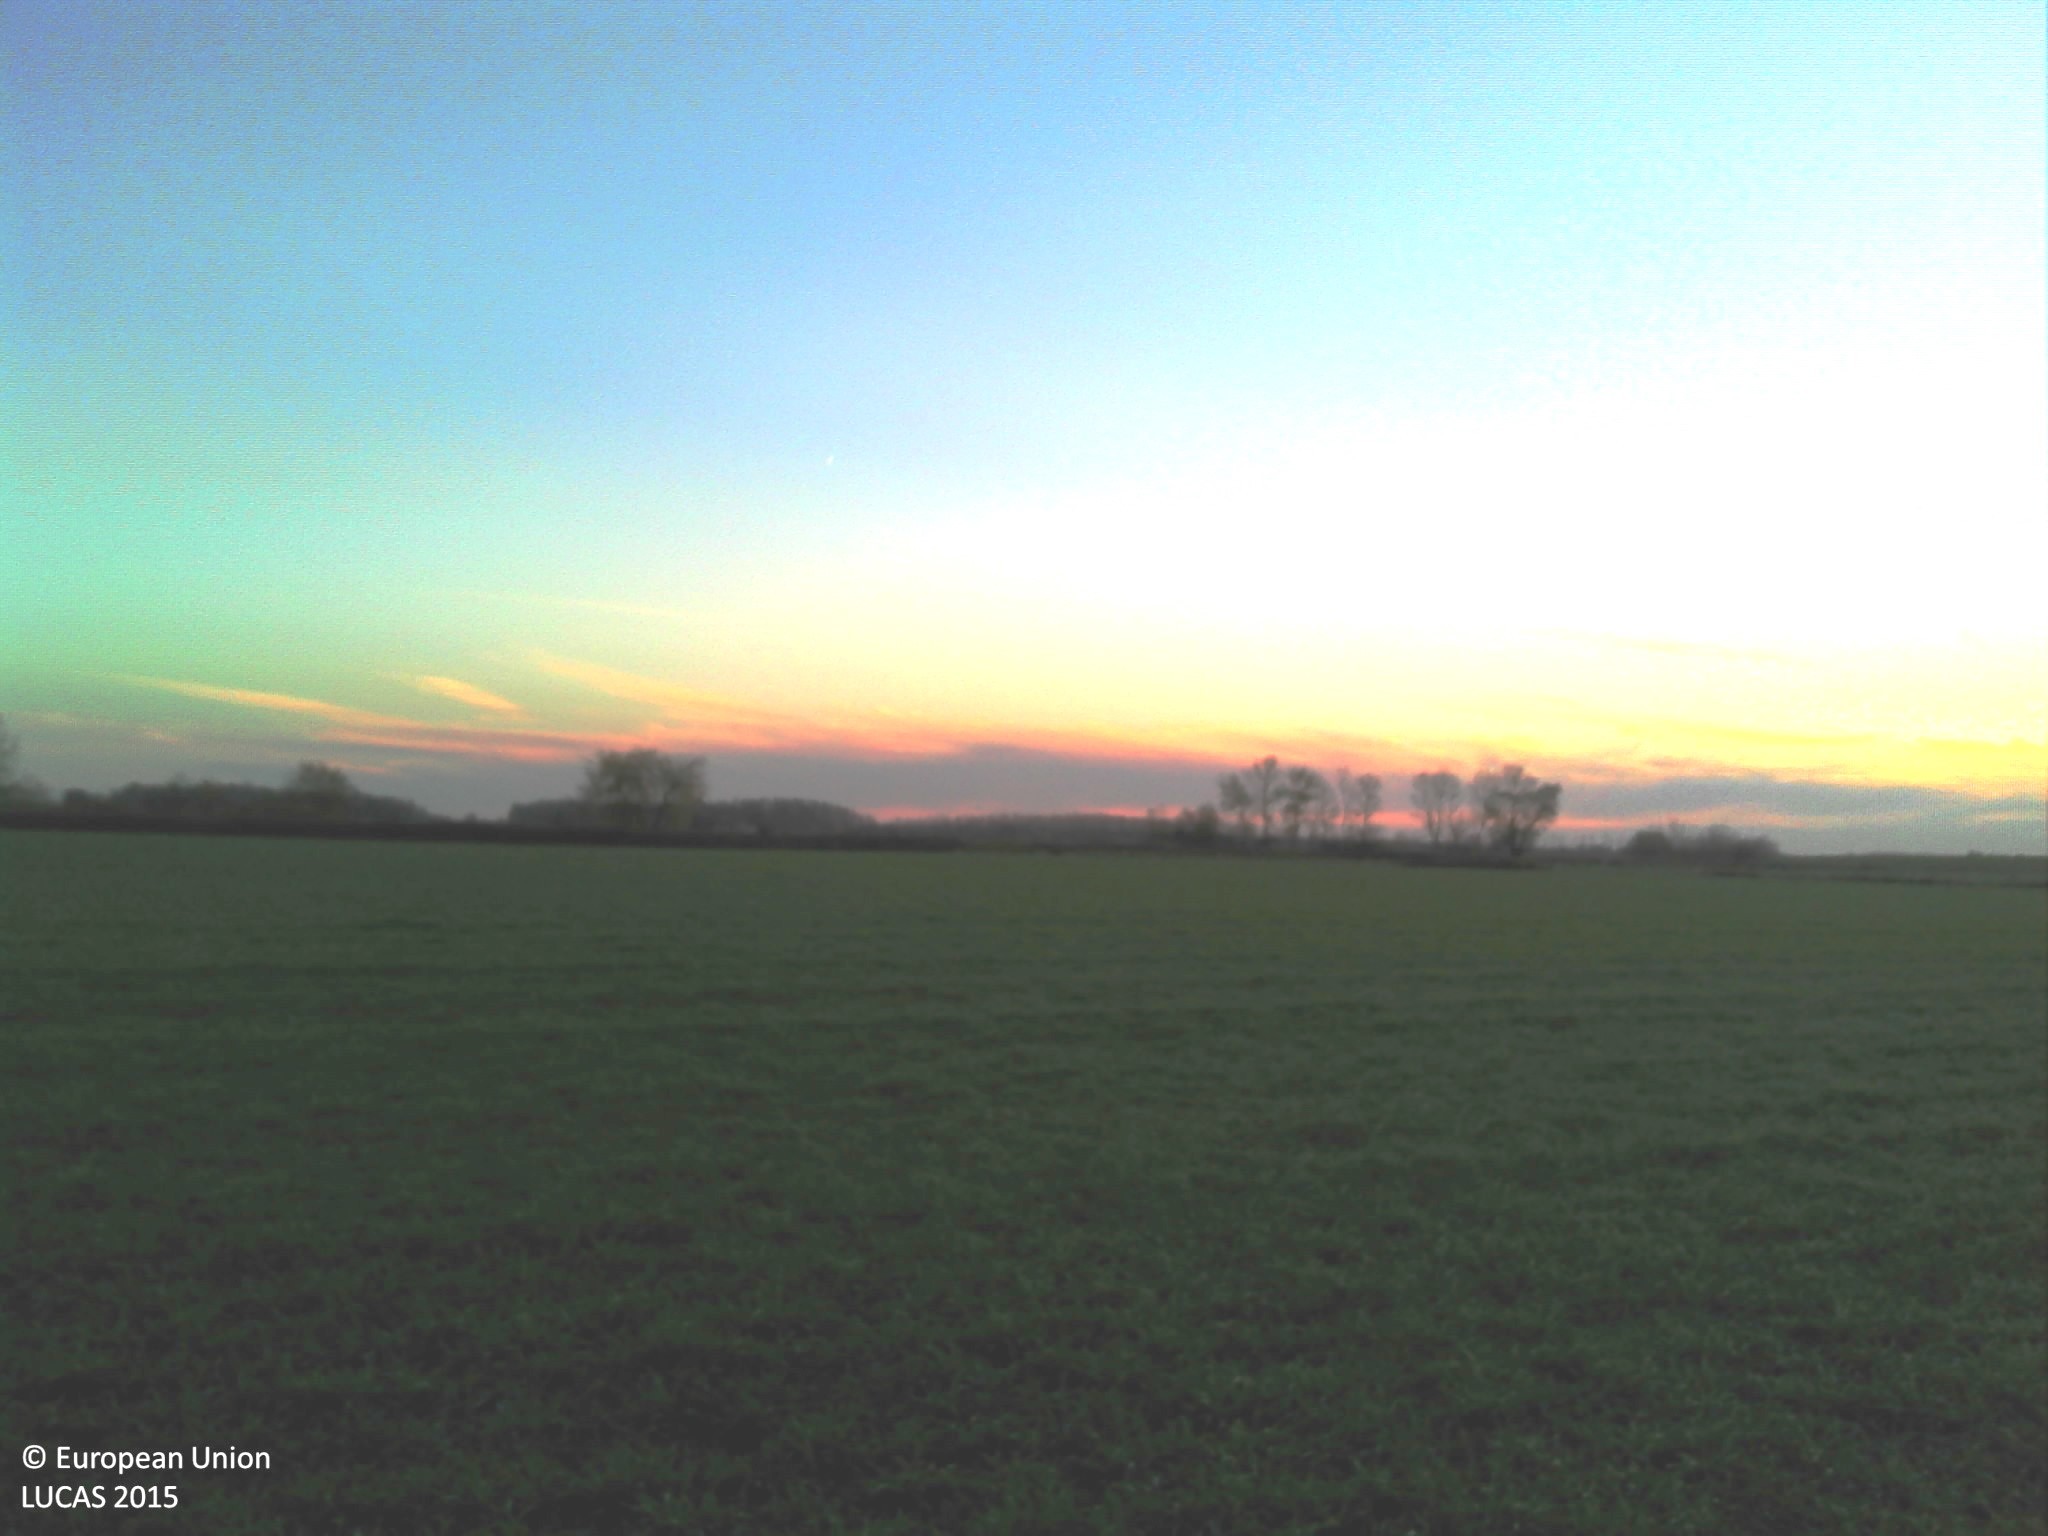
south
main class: Cropland
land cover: Temporary grasslands
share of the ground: > 75 %
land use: Agriculture (excluding fallow land and kitchen gardens)
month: December
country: FR
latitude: 46.0407
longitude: 5.1058
